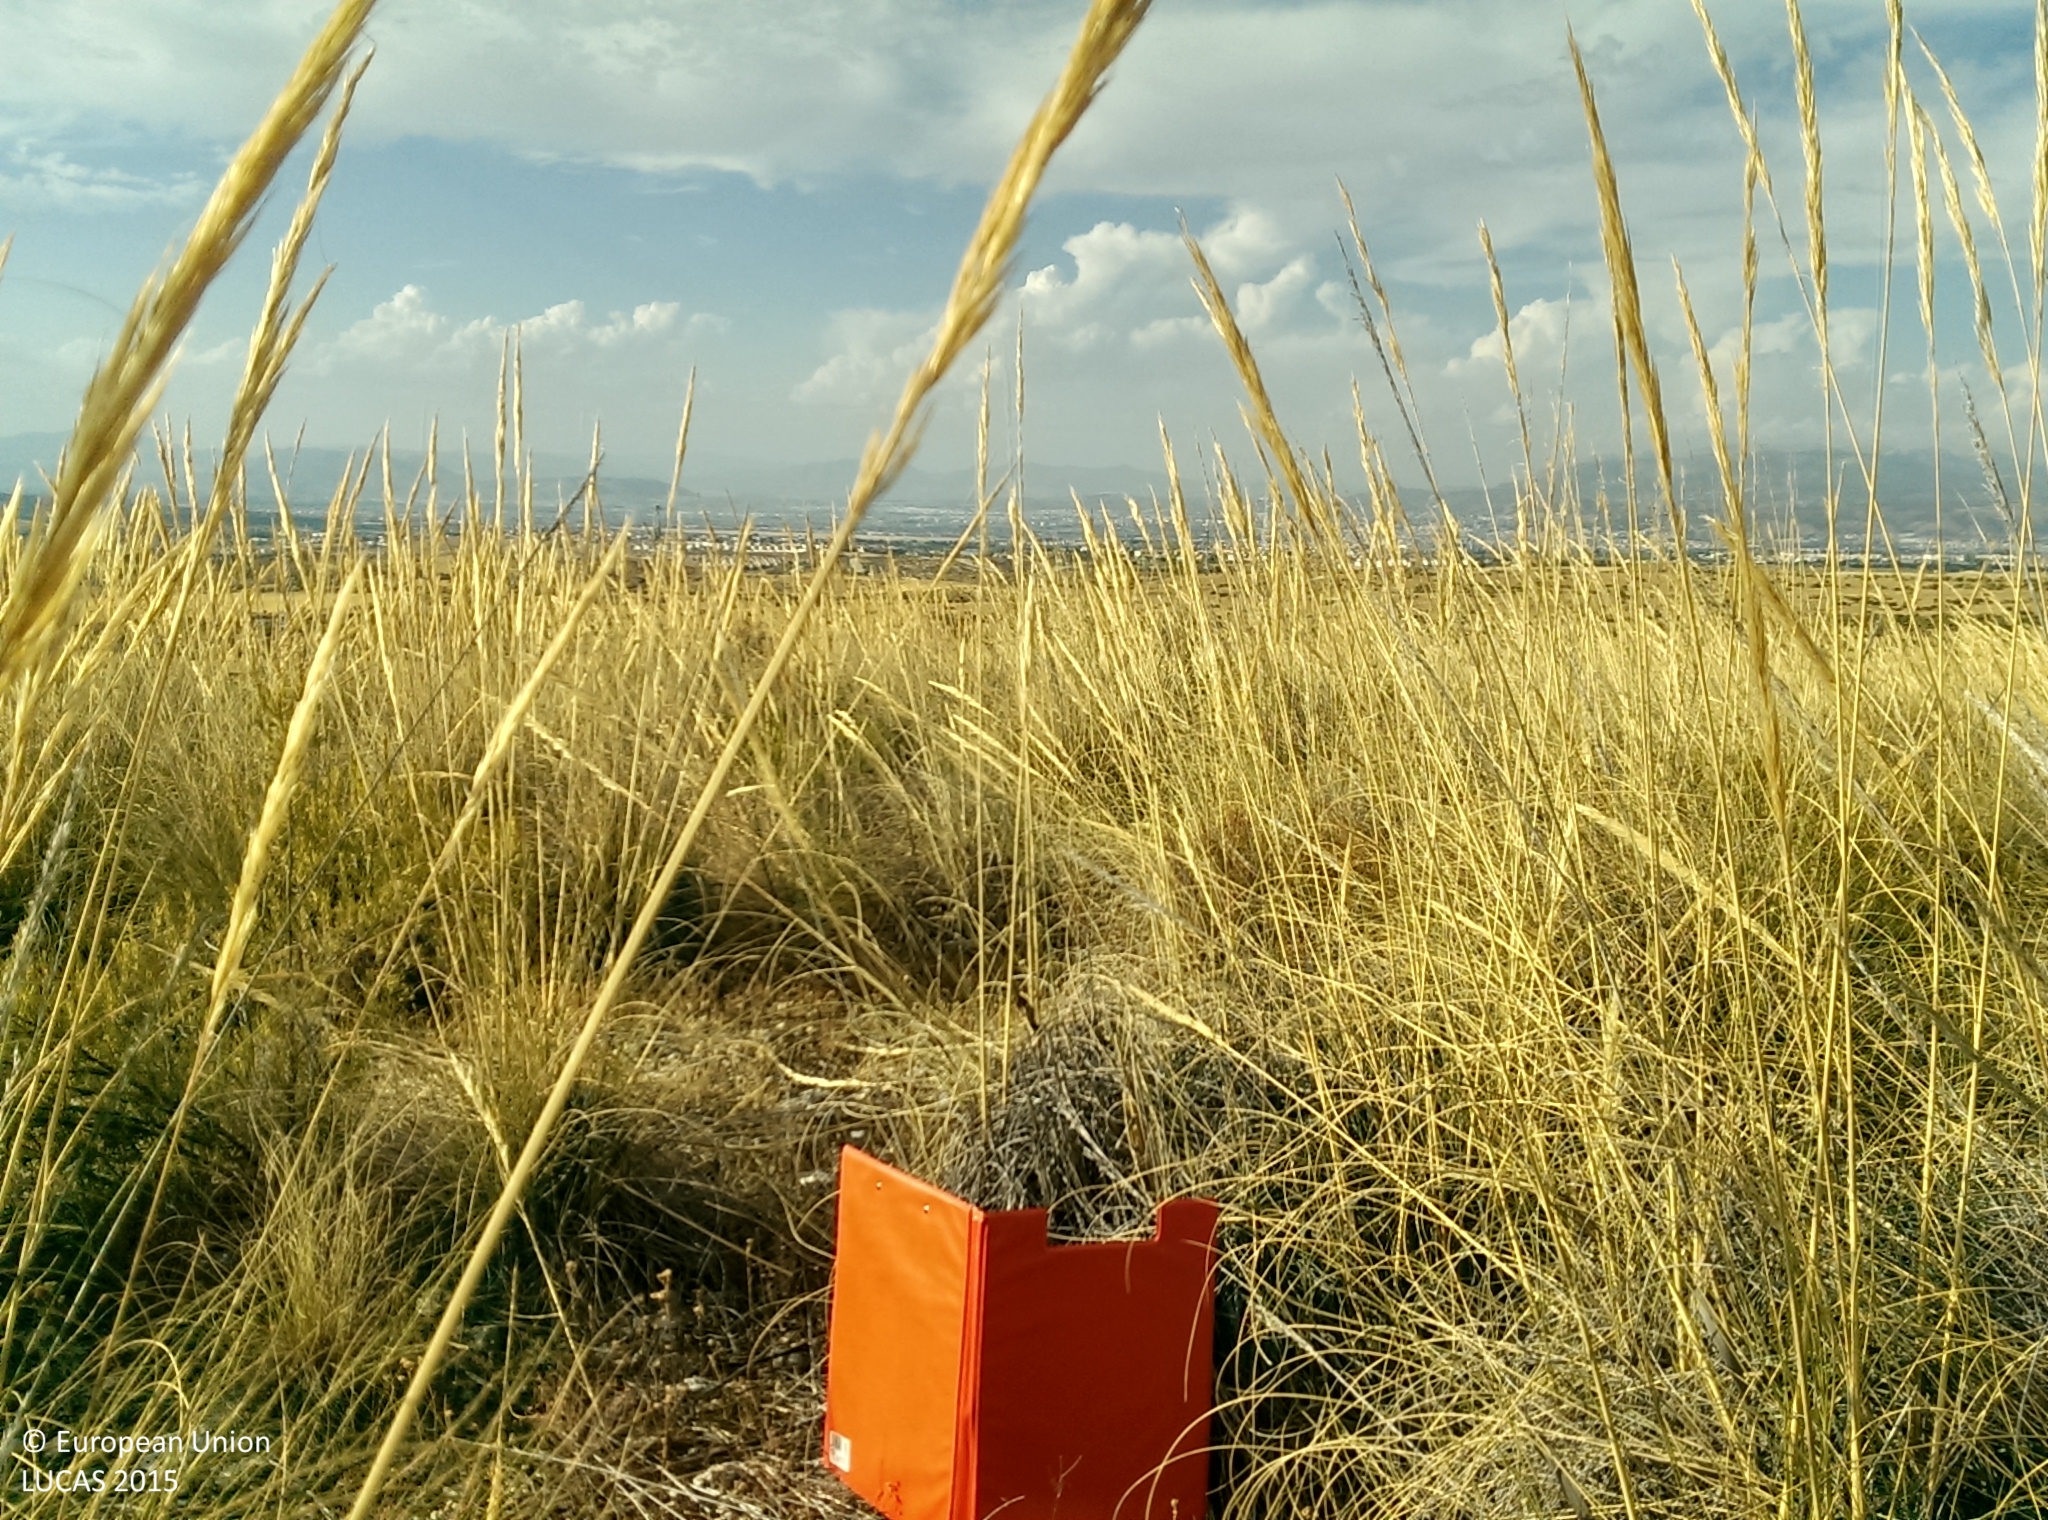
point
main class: Grassland
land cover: Grassland without tree/shrub cover
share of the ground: > 75 %
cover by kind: herbaceous plants 75 %, unconsolidated bare surface 20 %, shrubs 5 %
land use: Abandoned areas
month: August
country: ES
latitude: 37.0553
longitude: -3.6279
